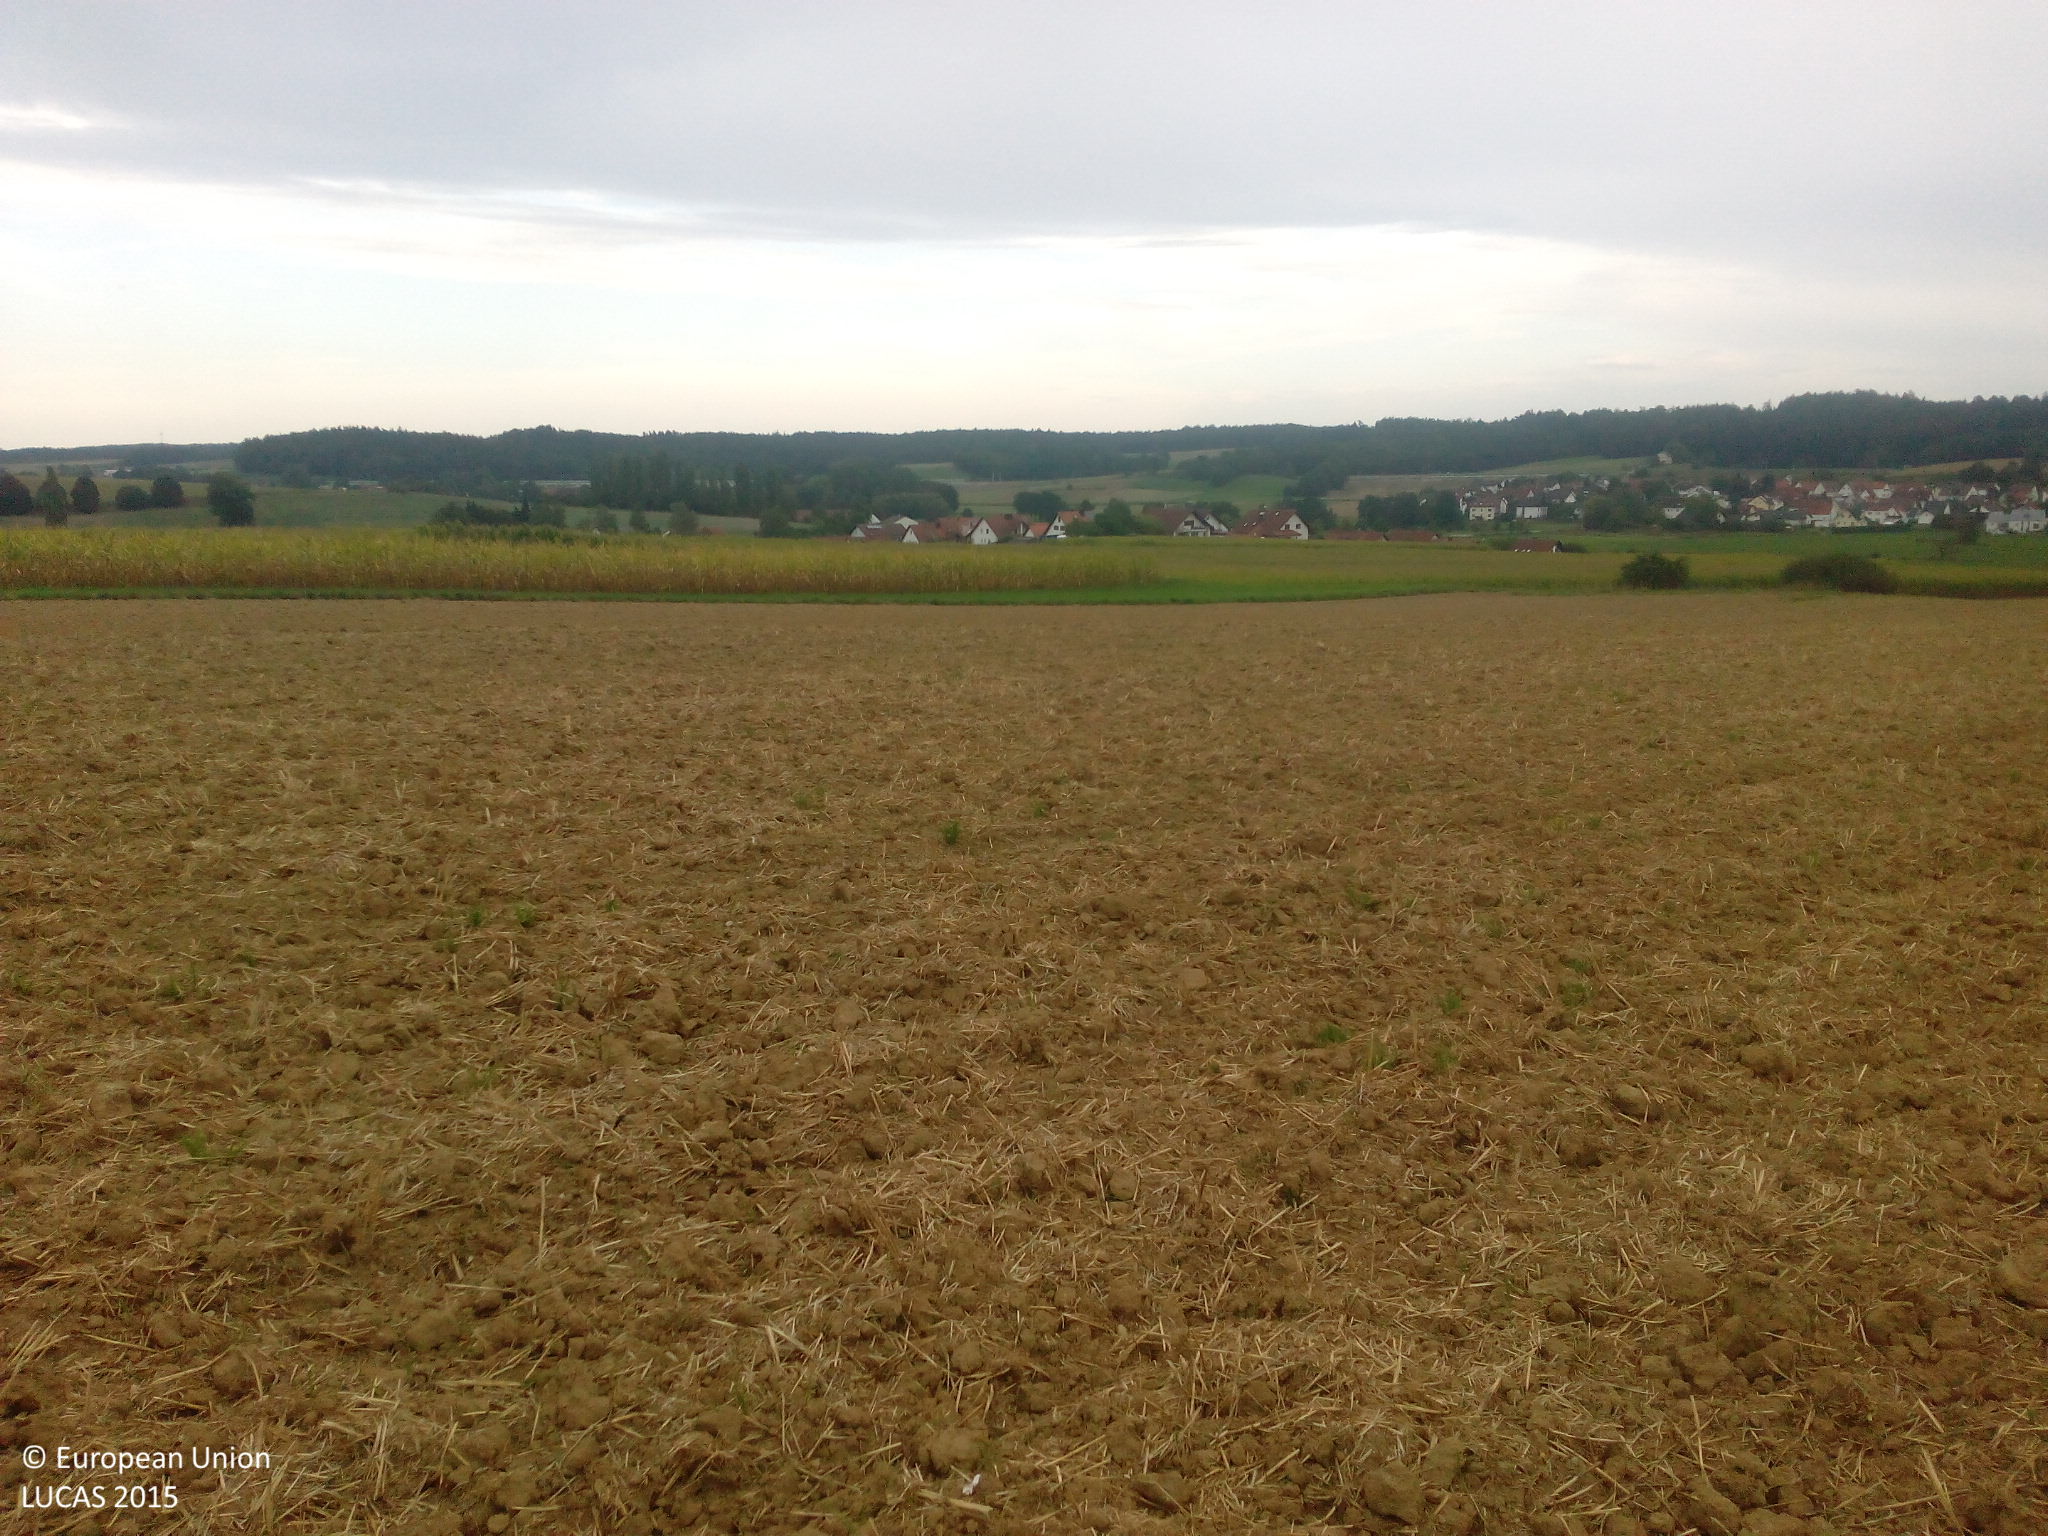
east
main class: Cropland
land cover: Common wheat
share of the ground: < 10 %
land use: Agriculture (excluding fallow land and kitchen gardens)
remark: Harvested field
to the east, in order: Common wheat; Other bare soil; Grassland without tree/shrub cover; Maize; Grassland without tree/shrub cover; Common wheat; Grass margins; Maize; Tracks; Maize; Other bare soil; Rape and turnip rape
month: September
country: DE
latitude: 48.4477
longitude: 11.4729
